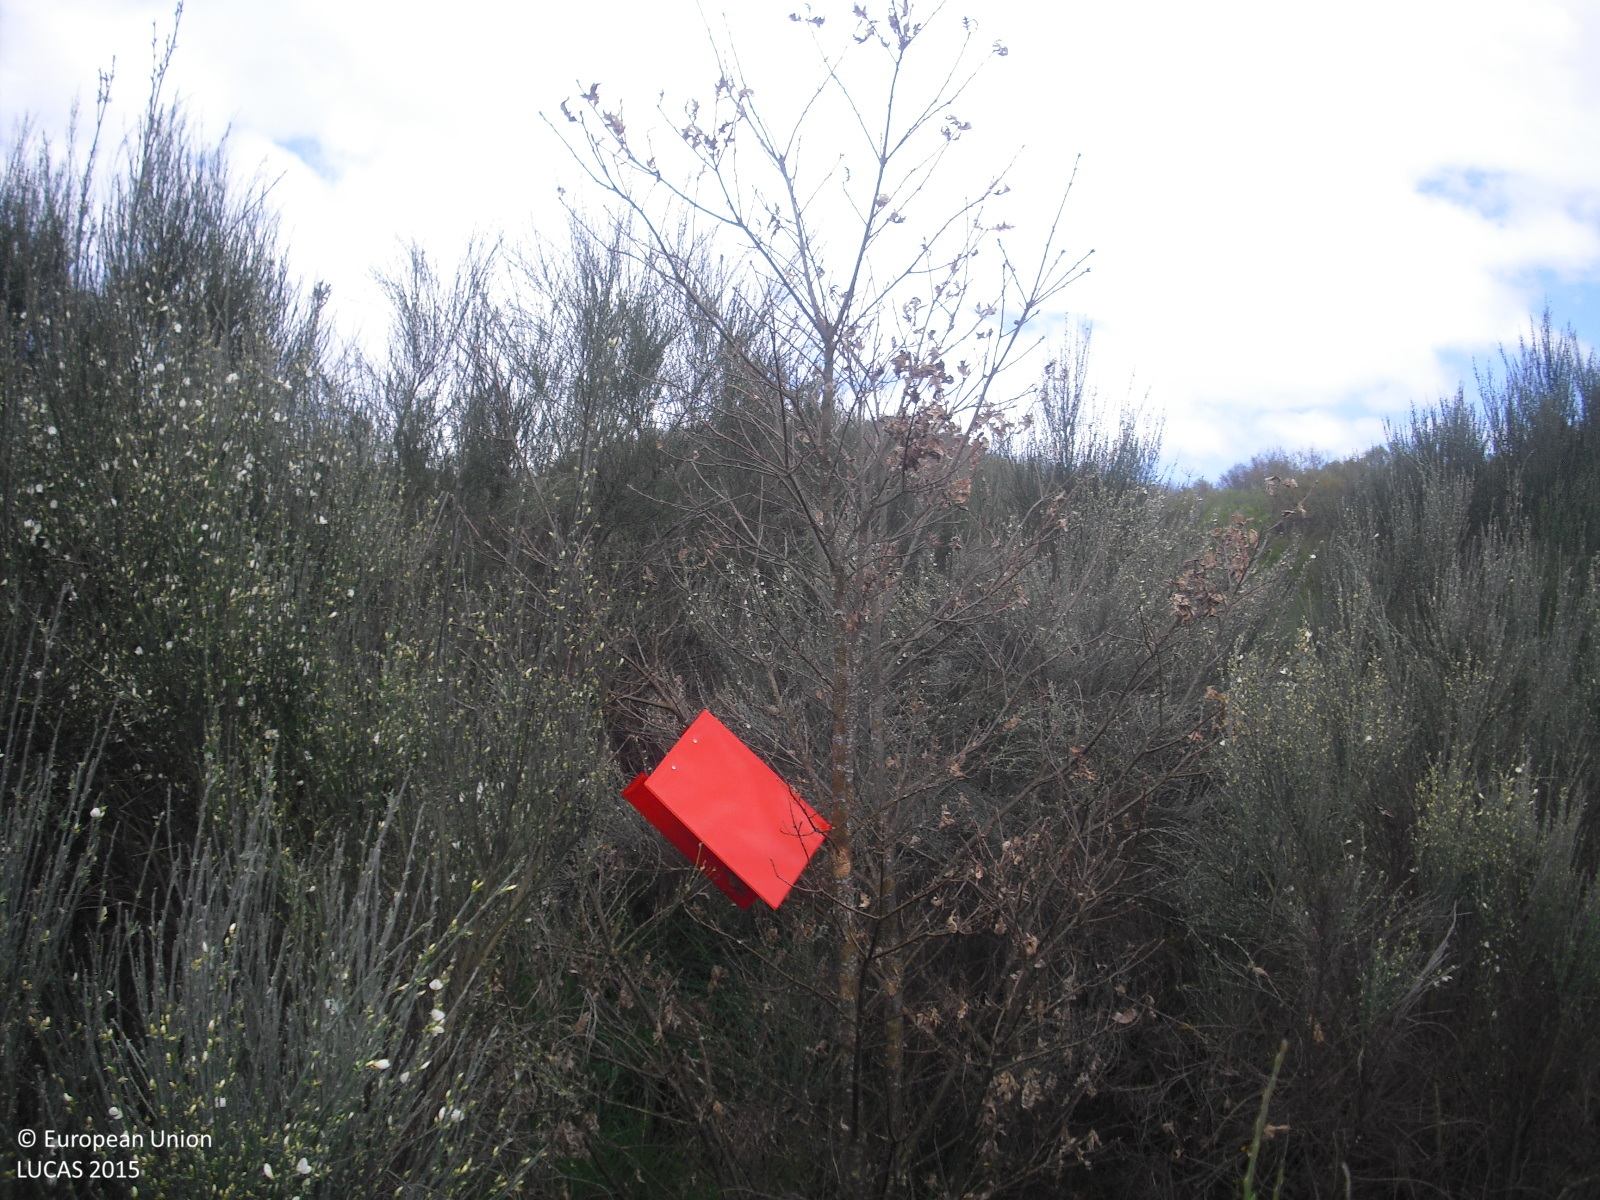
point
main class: Shrubland
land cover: Shrubland with sparse tree cover
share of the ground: > 75 %
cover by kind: shrubs 85 %, herbaceous plants 10 %, broadleaved forest trees 5 %
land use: Abandoned areas
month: April
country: ES
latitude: 41.9543
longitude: -7.8665
